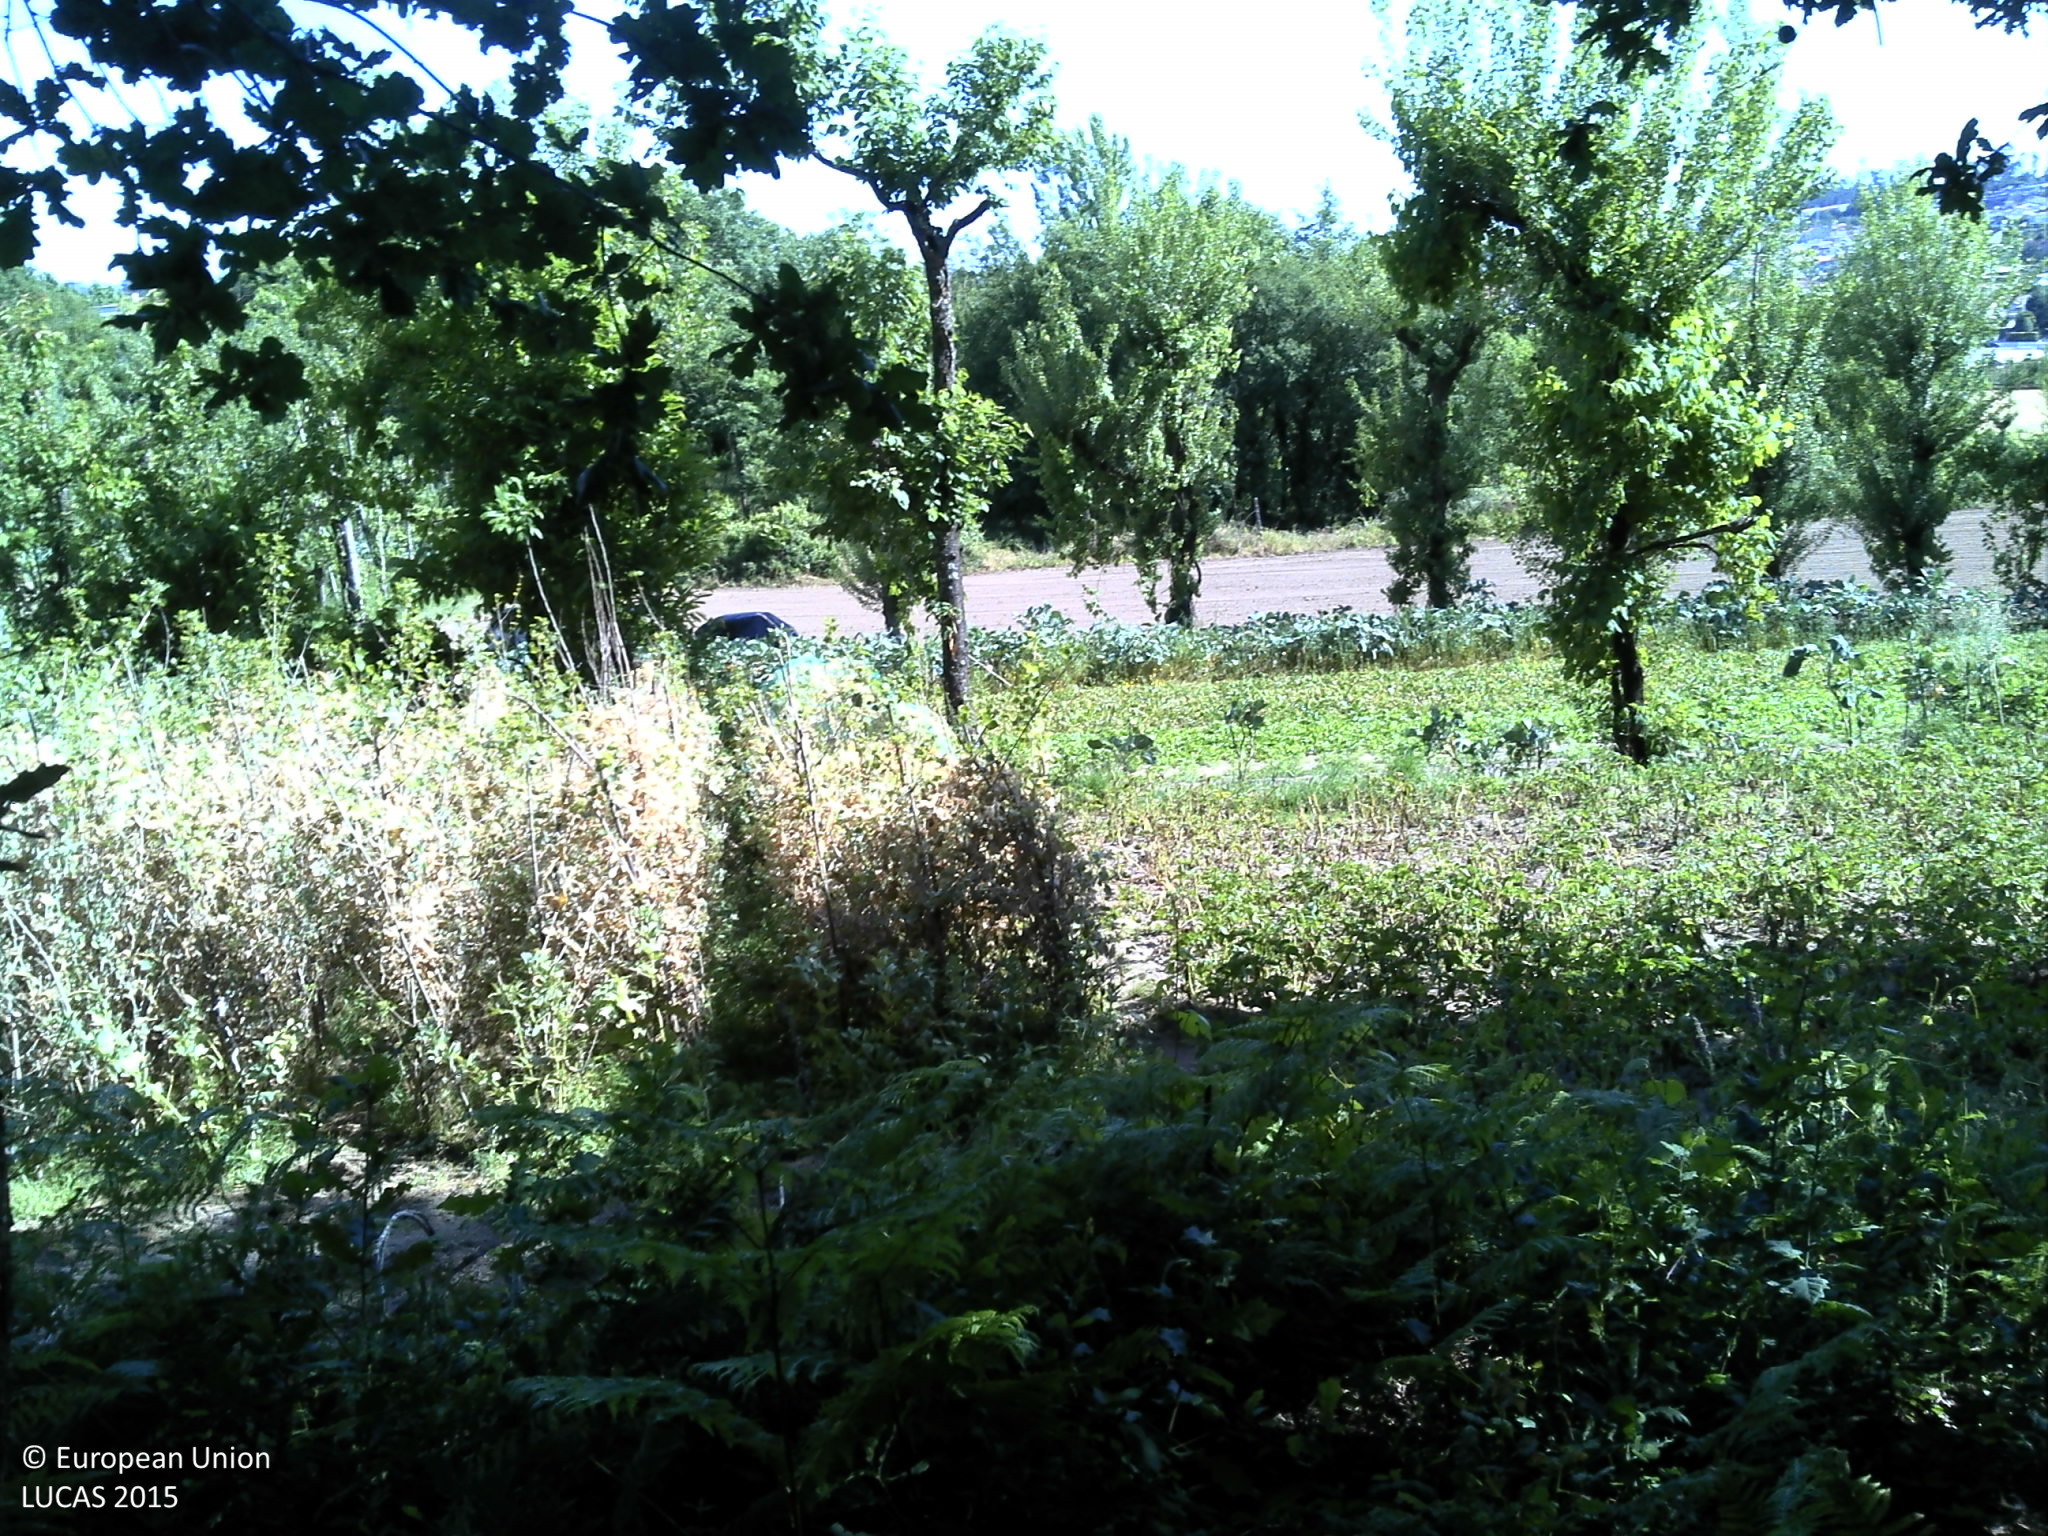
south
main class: Woodland
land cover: Broadleaved woodland
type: acidophilous oak and oak-birch forest
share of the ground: 50 - 75 %
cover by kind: broadleaved forest trees 60 %, unconsolidated bare surface 30 %, herbaceous plants 10 %
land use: Forestry
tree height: > 5 m
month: May
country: PT
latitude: 41.4663
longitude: -8.3126
